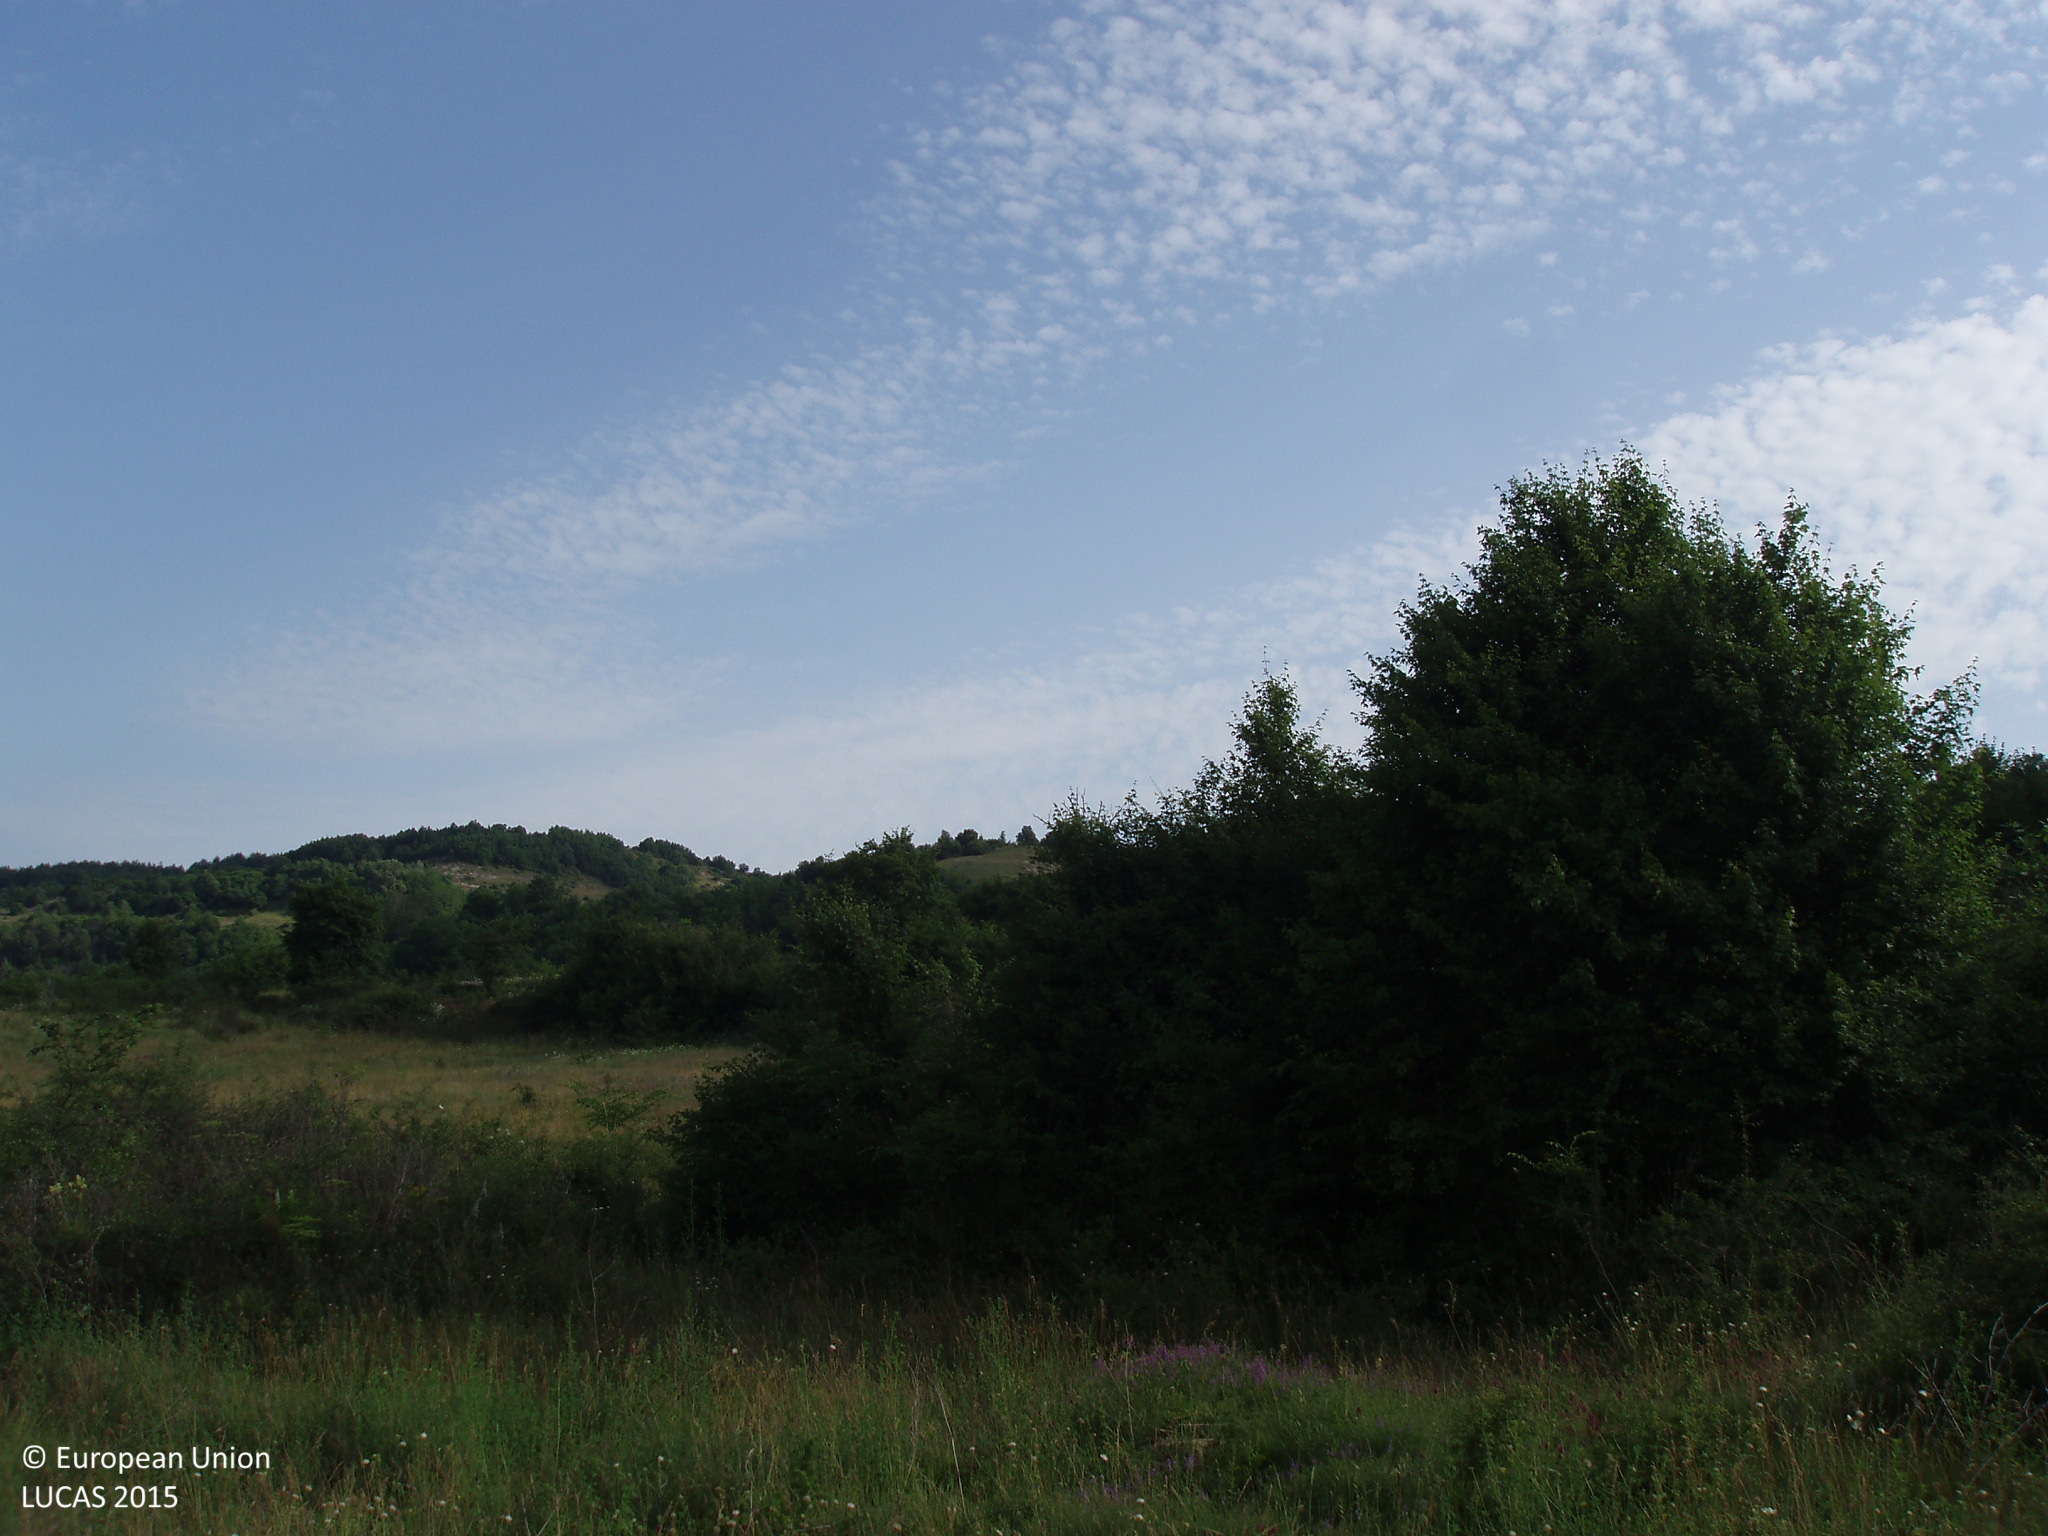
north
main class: Grassland
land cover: Grassland without tree/shrub cover
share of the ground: > 75 %
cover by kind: herbaceous plants 100 %
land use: Agriculture (excluding fallow land and kitchen gardens)
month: June
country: BG
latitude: 41.4651
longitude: 23.8091
